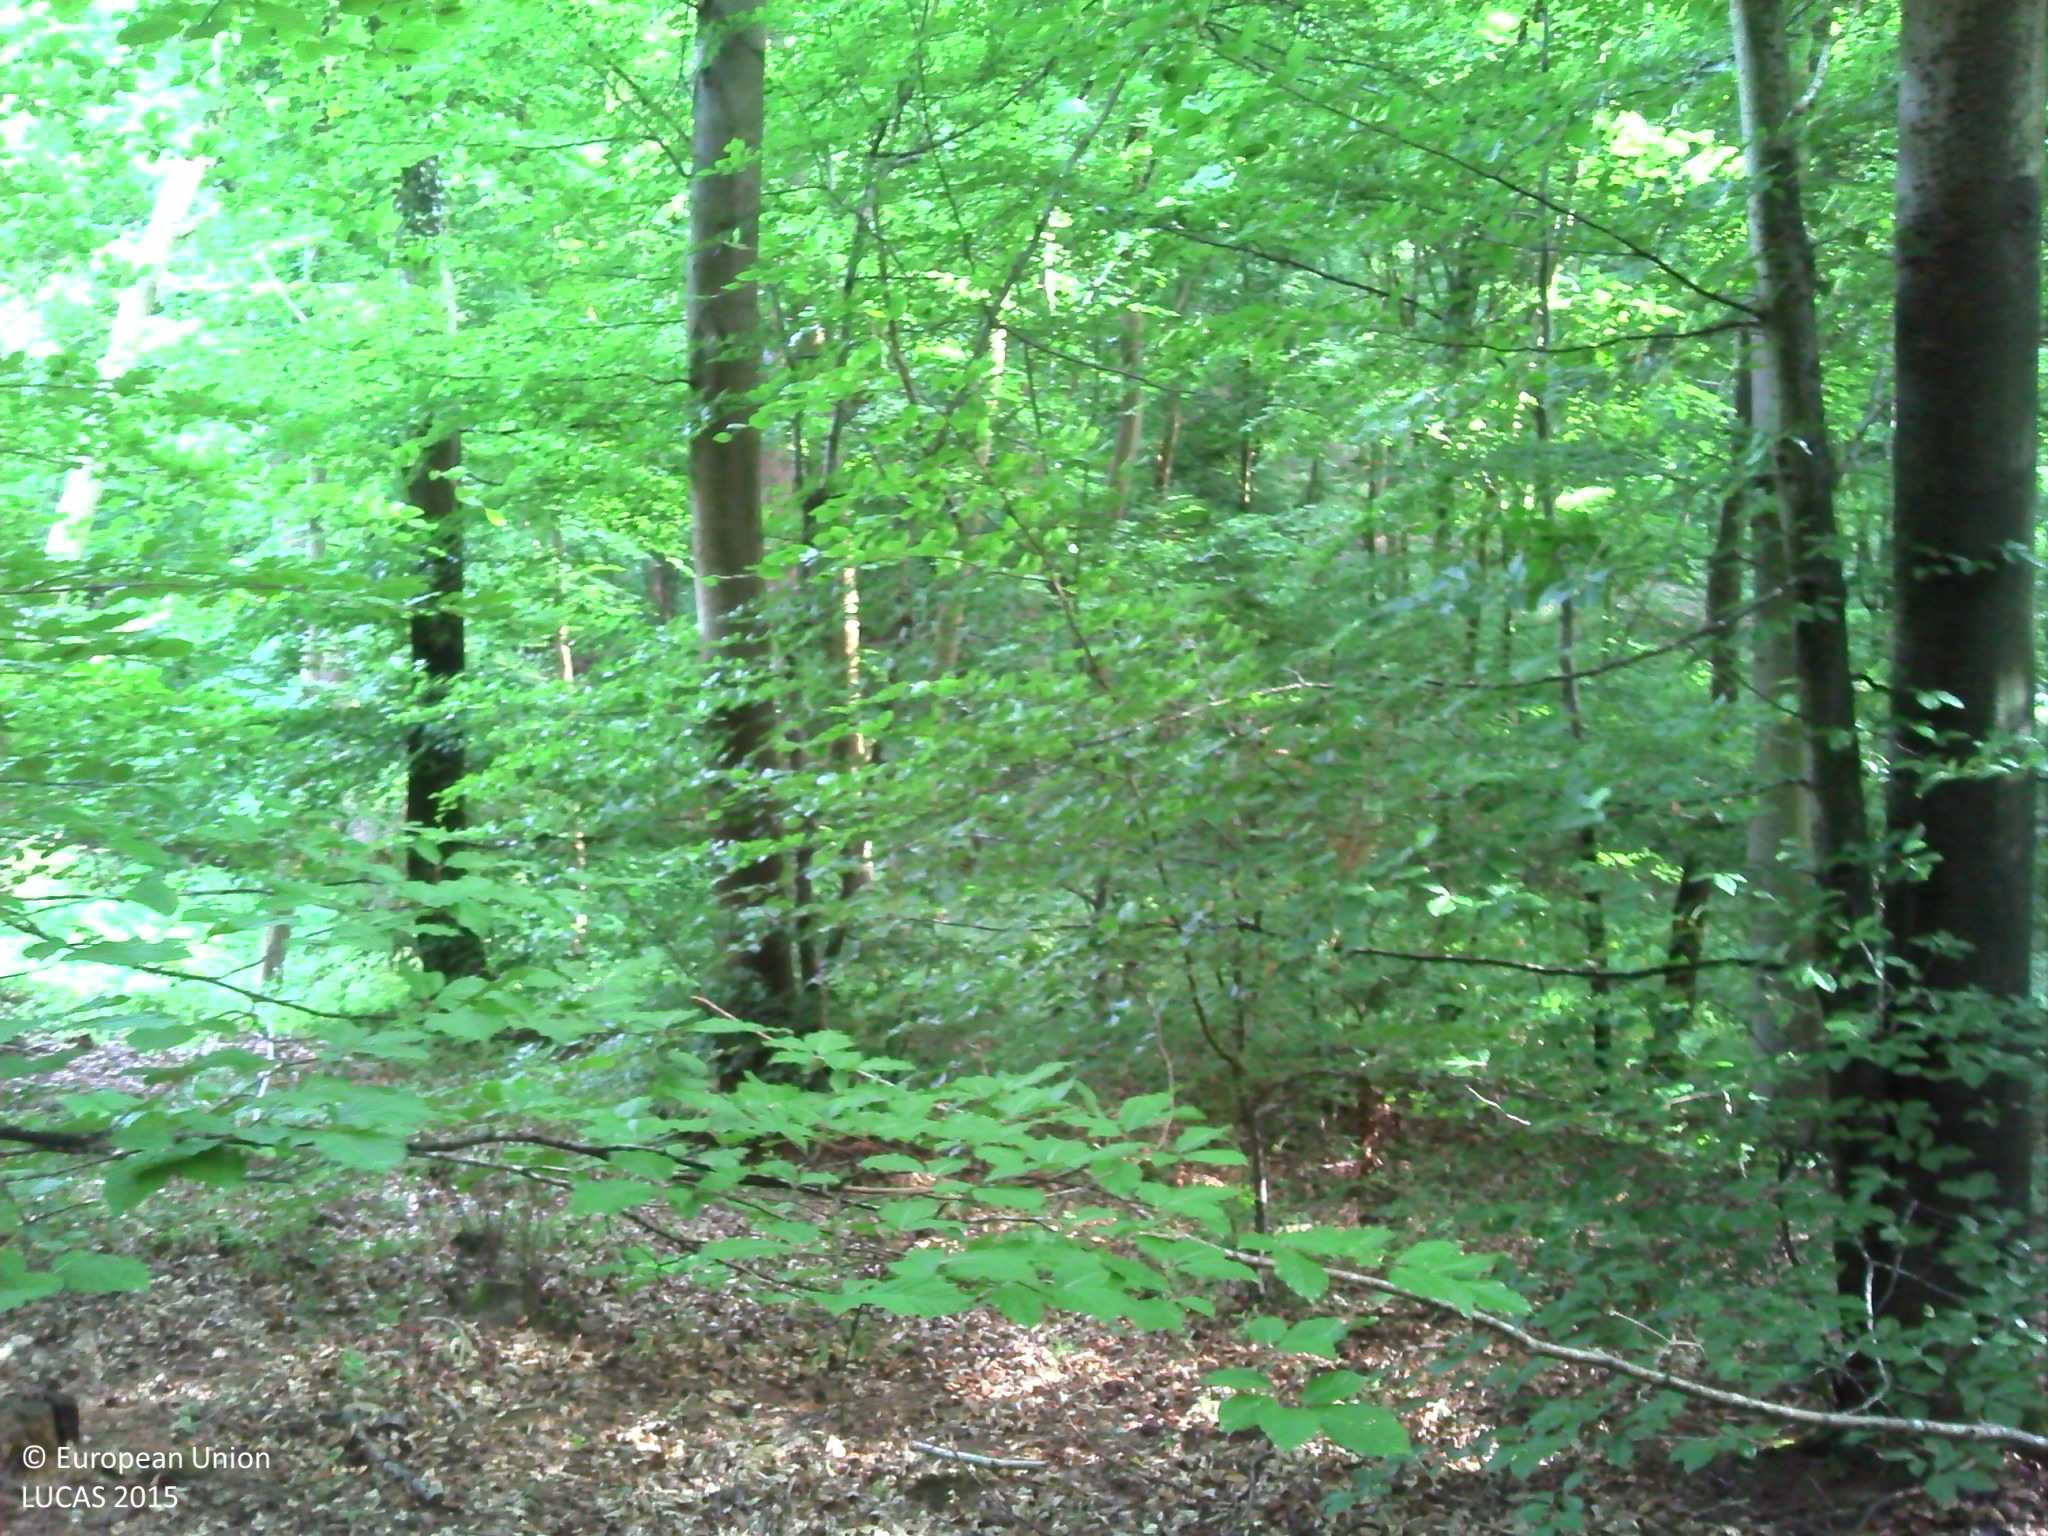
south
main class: Woodland
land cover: Other mixed woodland
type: beech forest
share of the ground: > 75 %
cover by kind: broadleaved forest trees 70 %, coniferous forest trees 25 %, herbaceous plants 5 %
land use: Forestry
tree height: > 5 m
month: June
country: FR
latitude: 49.2623
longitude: 1.1712
